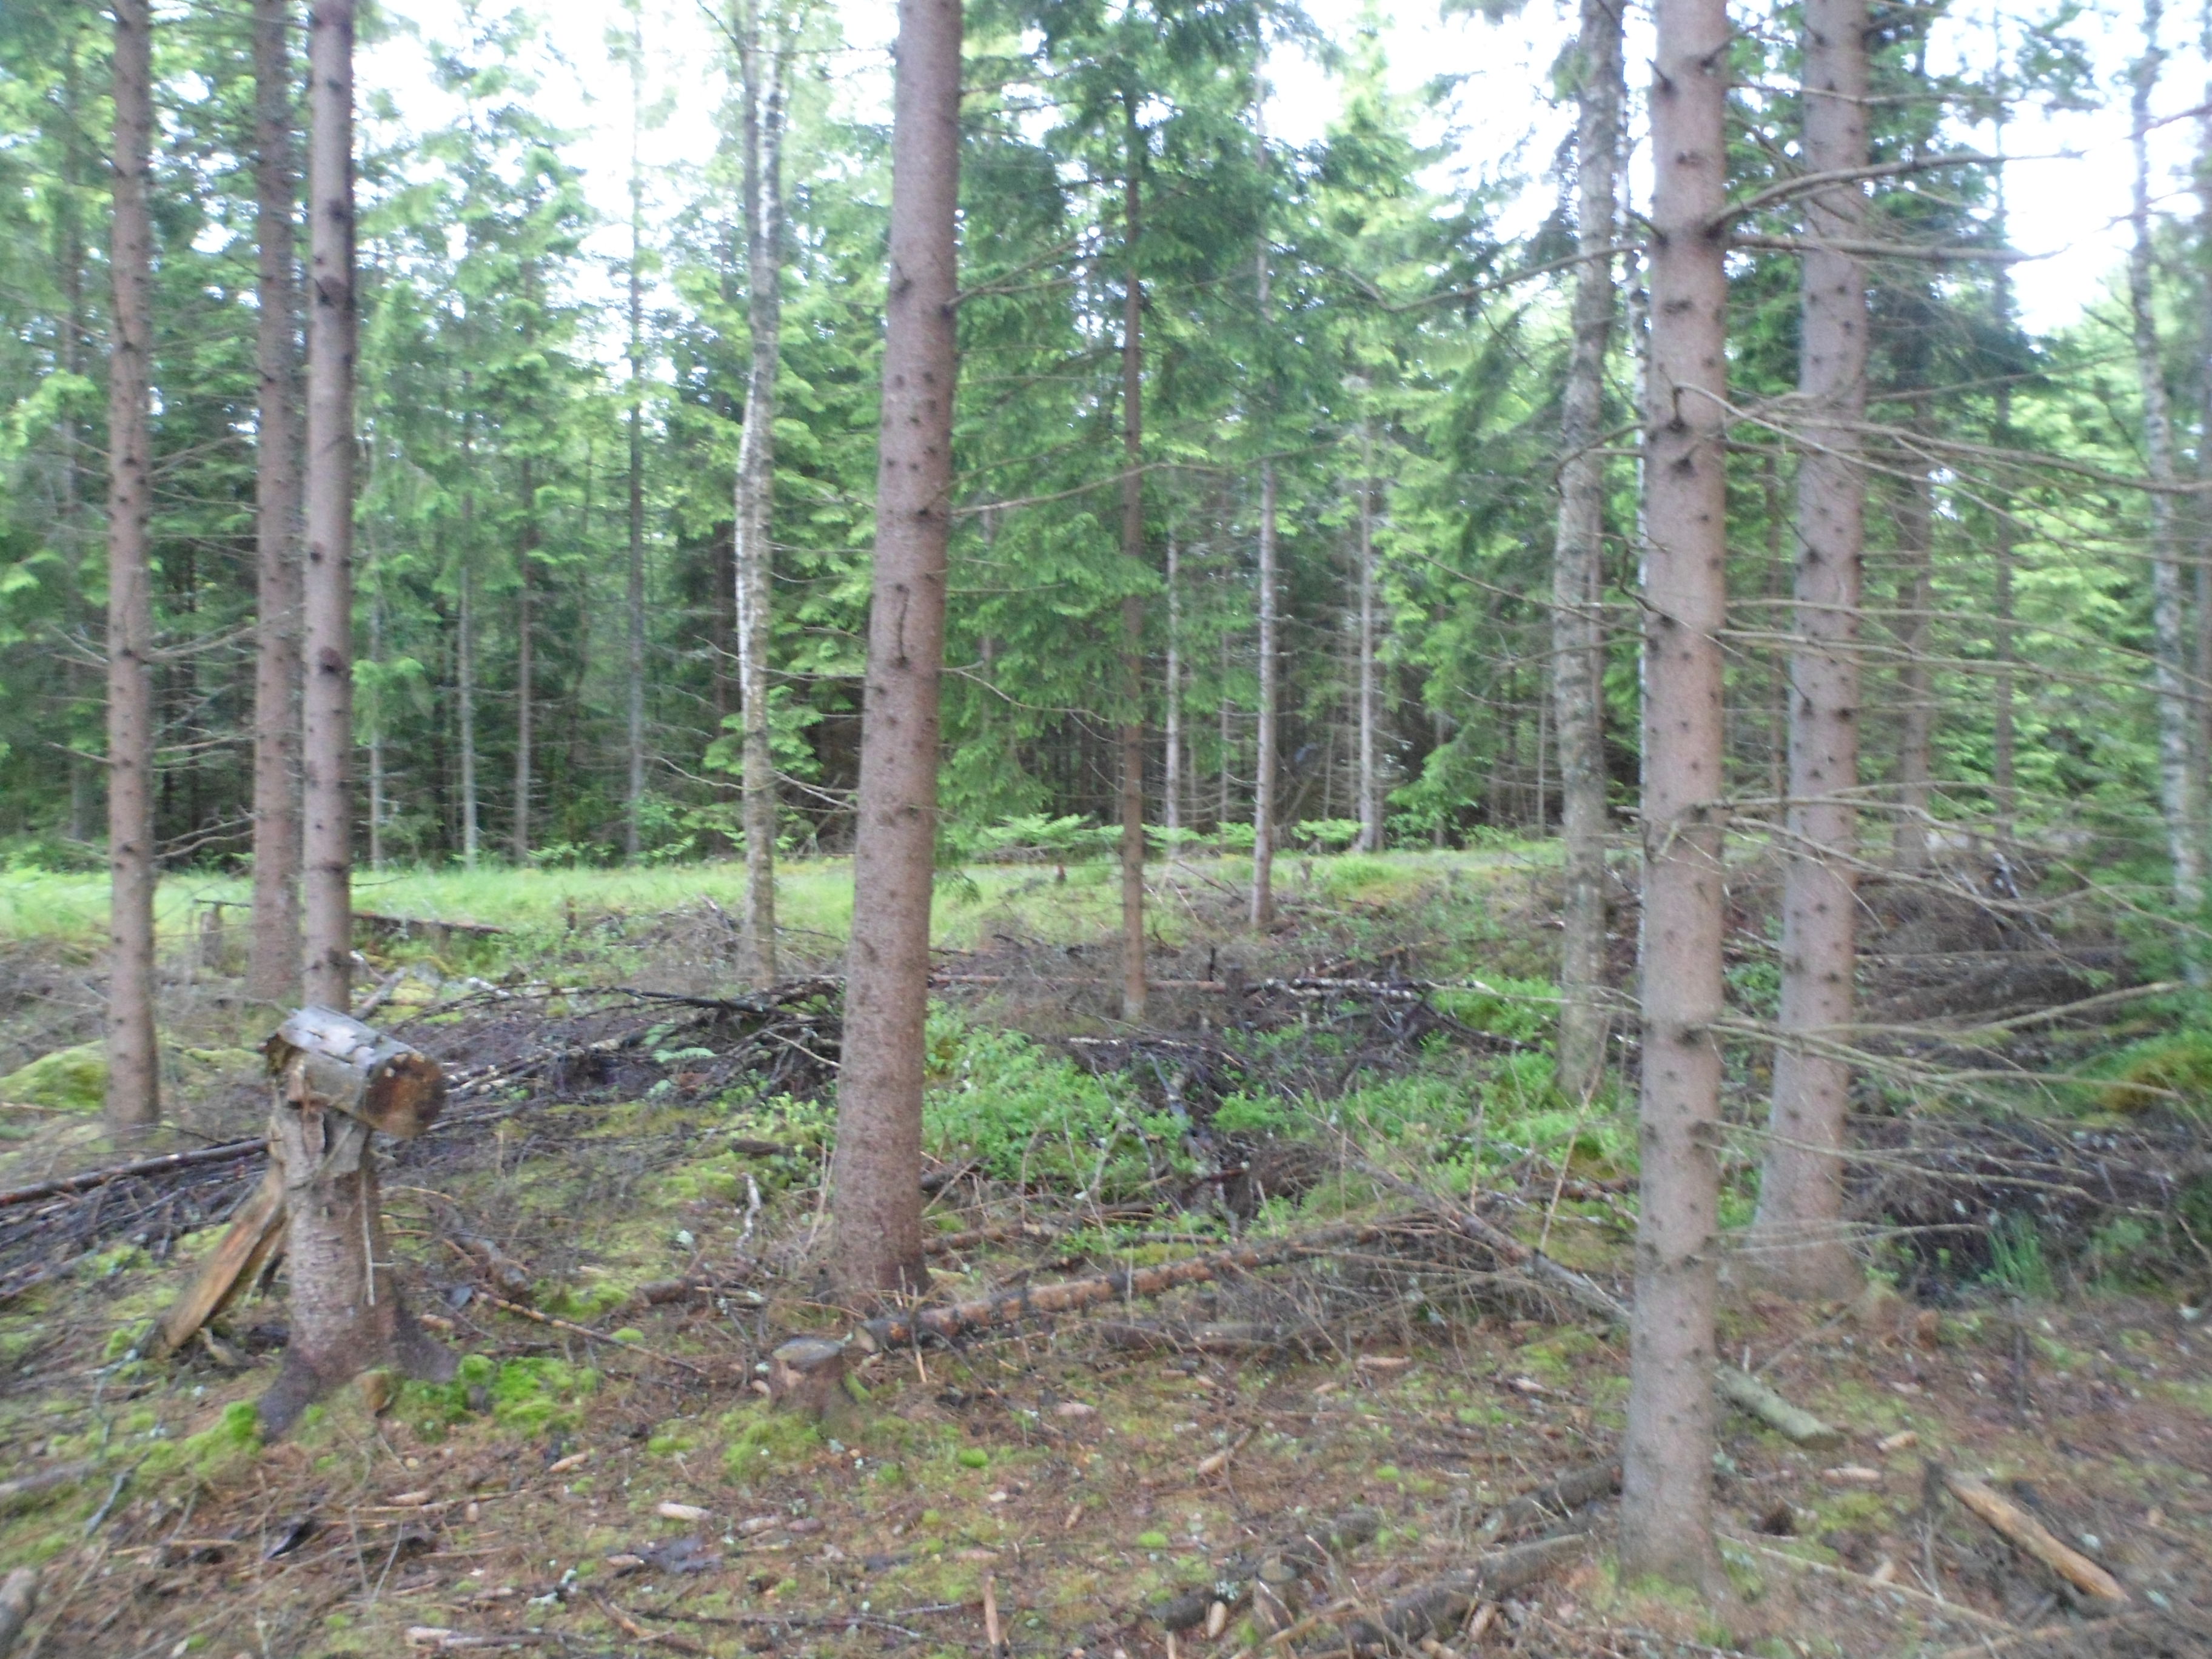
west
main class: Woodland
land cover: Spruce dominated coniferous woodland
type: boreal forest
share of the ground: > 75 %
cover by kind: coniferous forest trees 75 %, lichens and mosses 15 %, unconsolidated bare surface 10 %
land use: Forestry
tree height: > 5 m
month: June
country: SE
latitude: 56.8896
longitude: 14.3136
